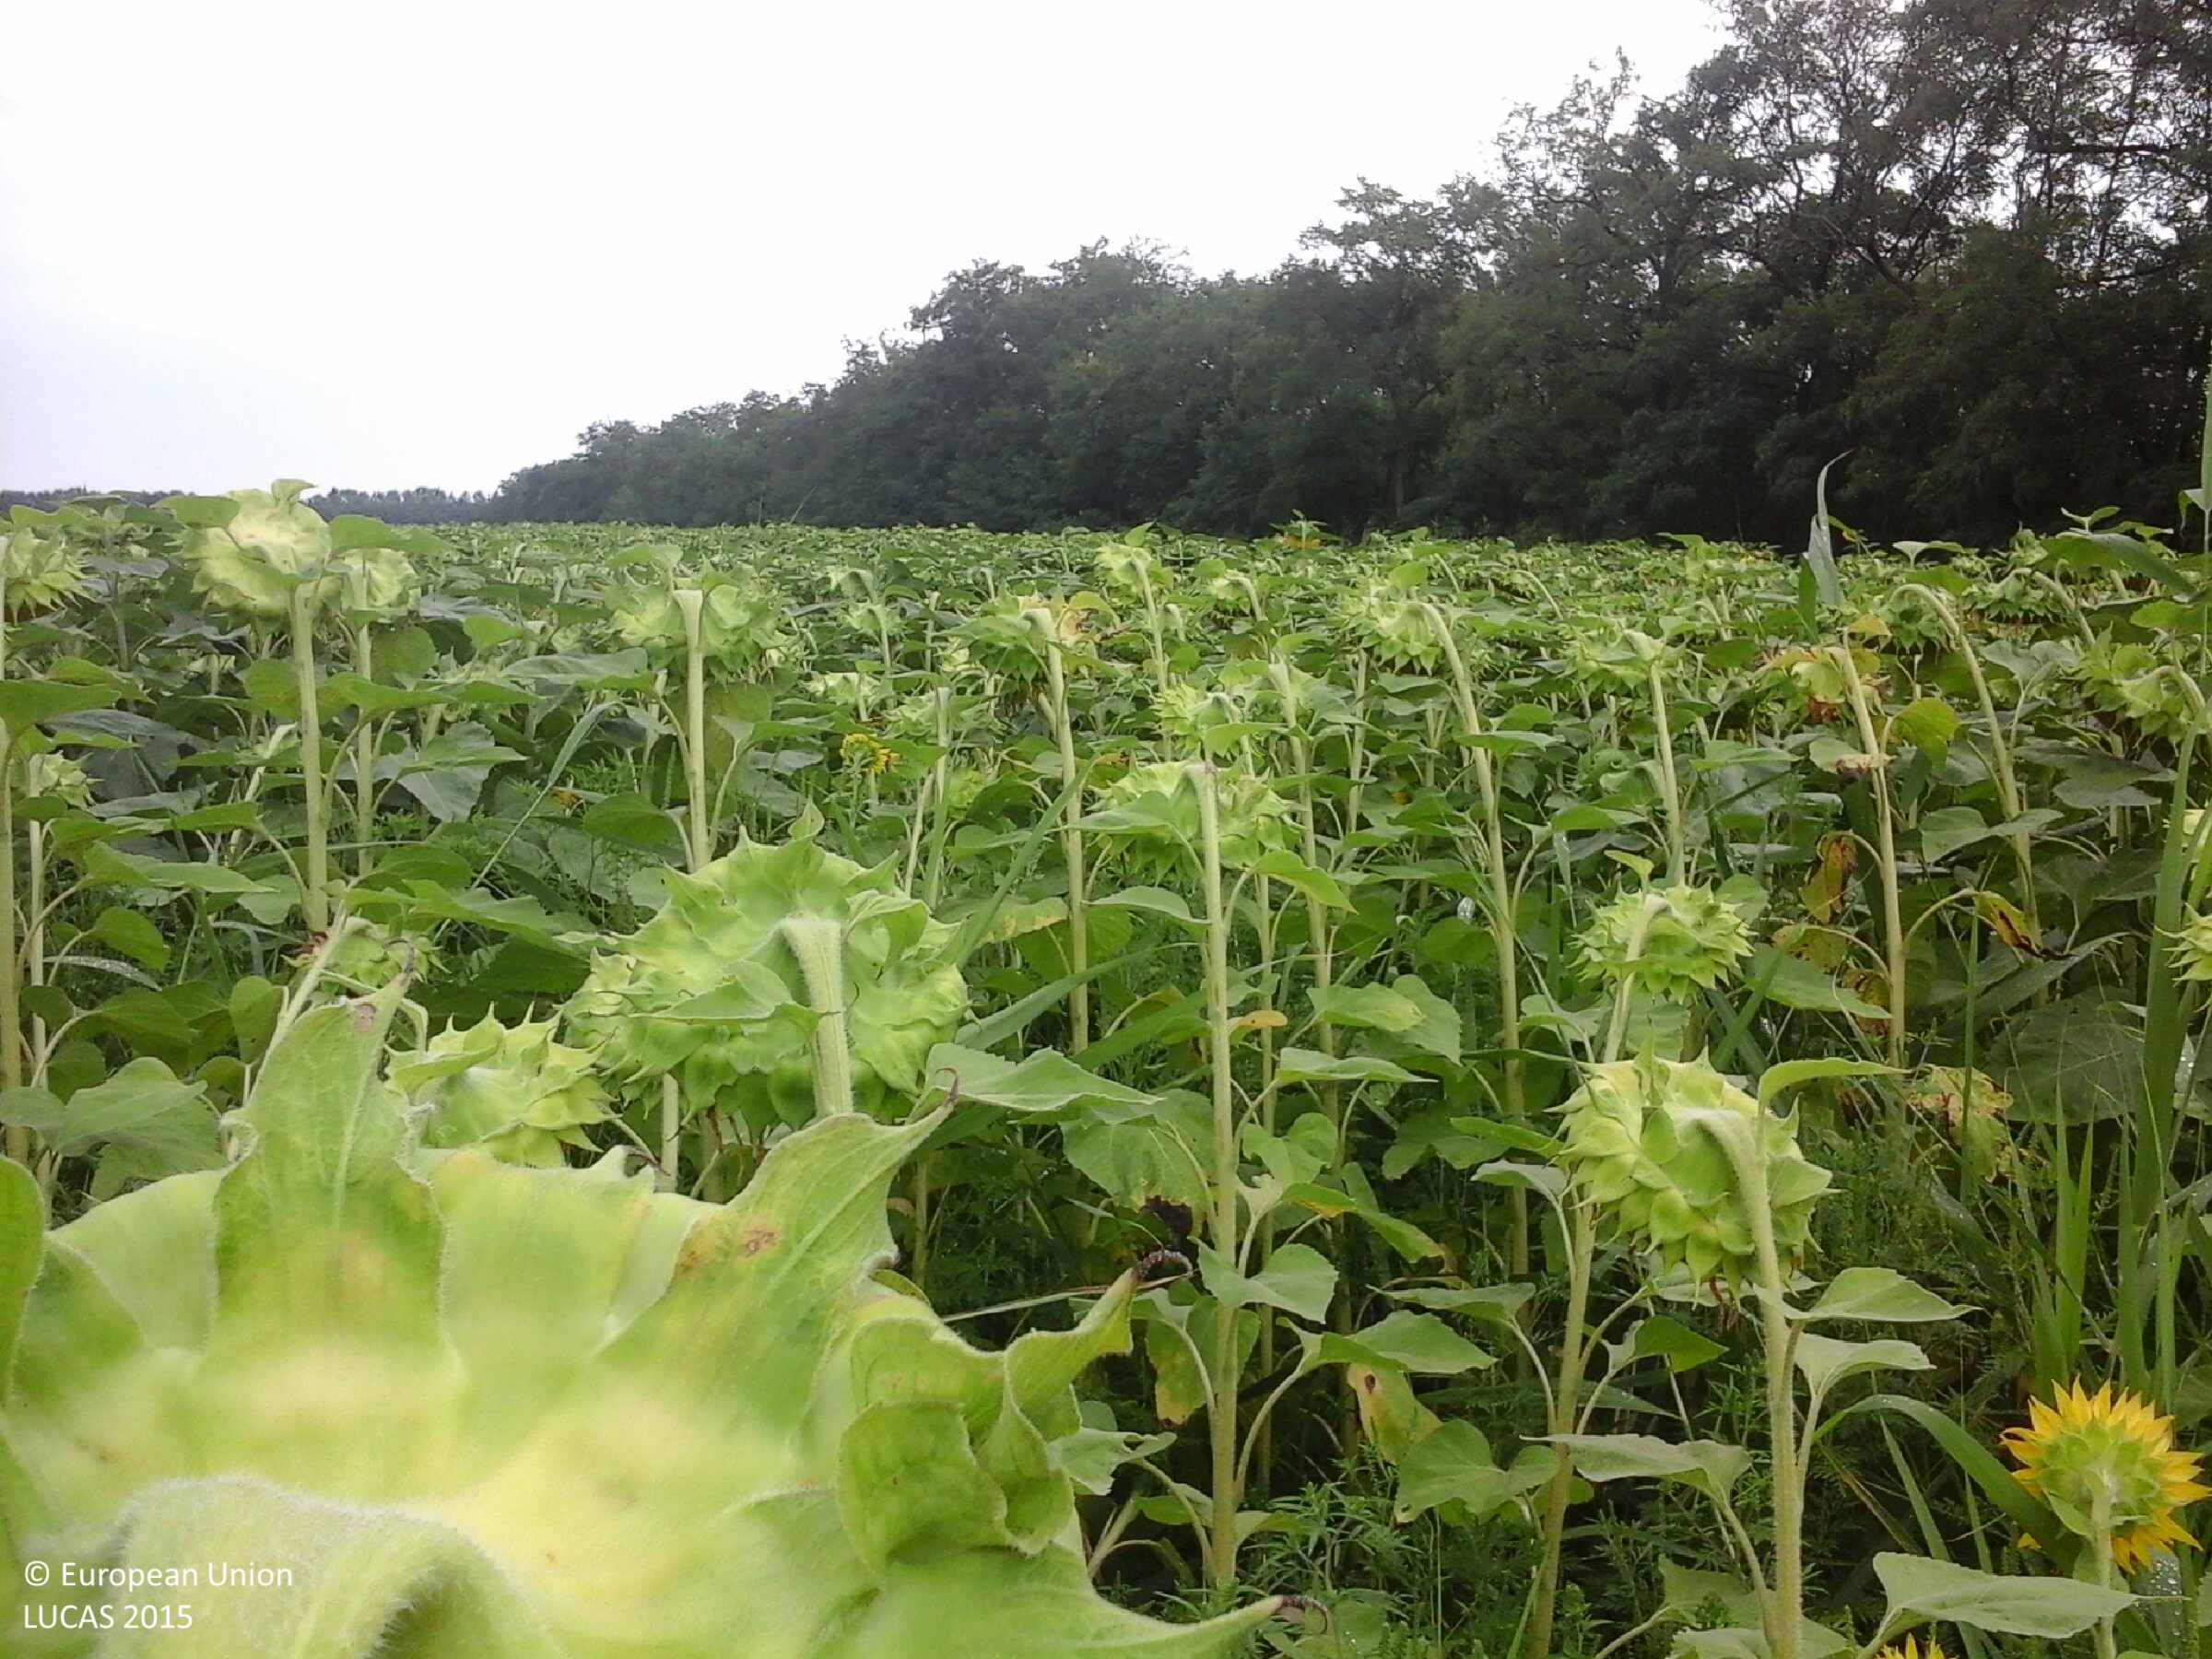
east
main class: Cropland
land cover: Sunflower
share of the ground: > 75 %
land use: Agriculture (excluding fallow land and kitchen gardens)
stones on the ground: < 10 %
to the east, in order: Sunflower; Broadleaved woodland
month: August
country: HU
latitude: 47.5655
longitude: 20.7875
